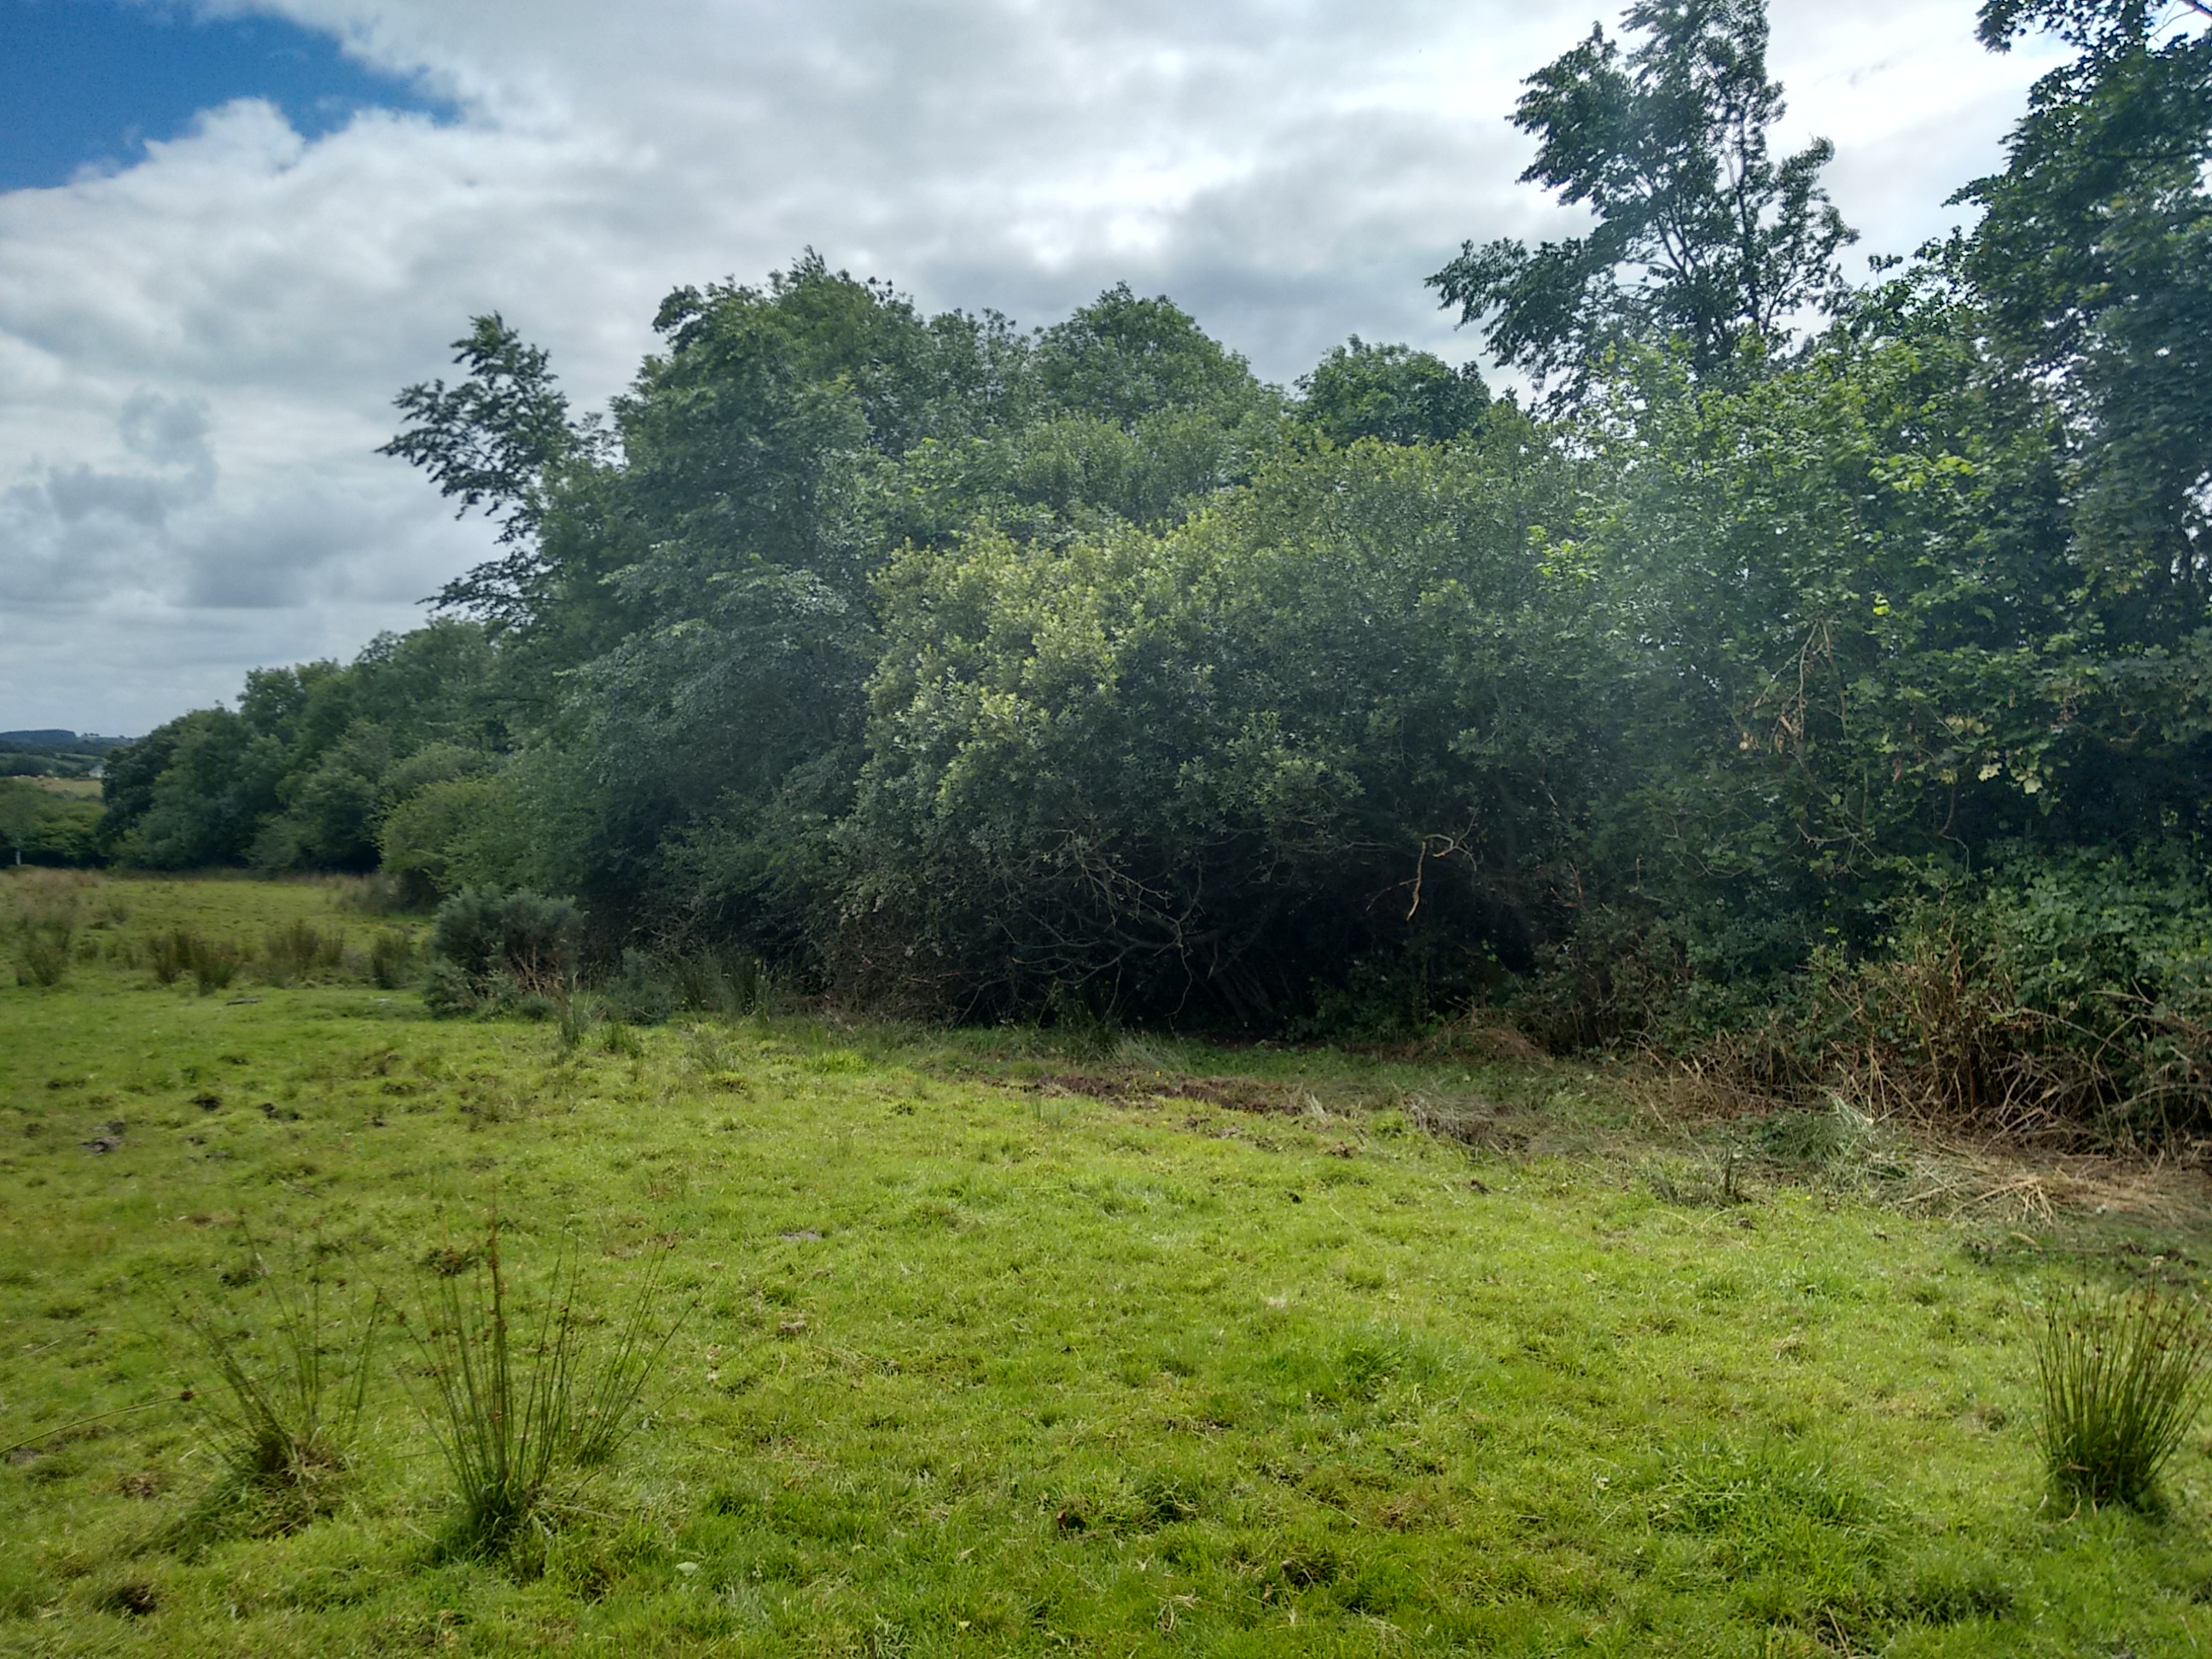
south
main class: Grassland
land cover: Grassland without tree/shrub cover
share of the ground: > 75 %
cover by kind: herbaceous plants 100 %
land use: Agriculture (excluding fallow land and kitchen gardens)
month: August
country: GB
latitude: 54.4987
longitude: -6.9214
